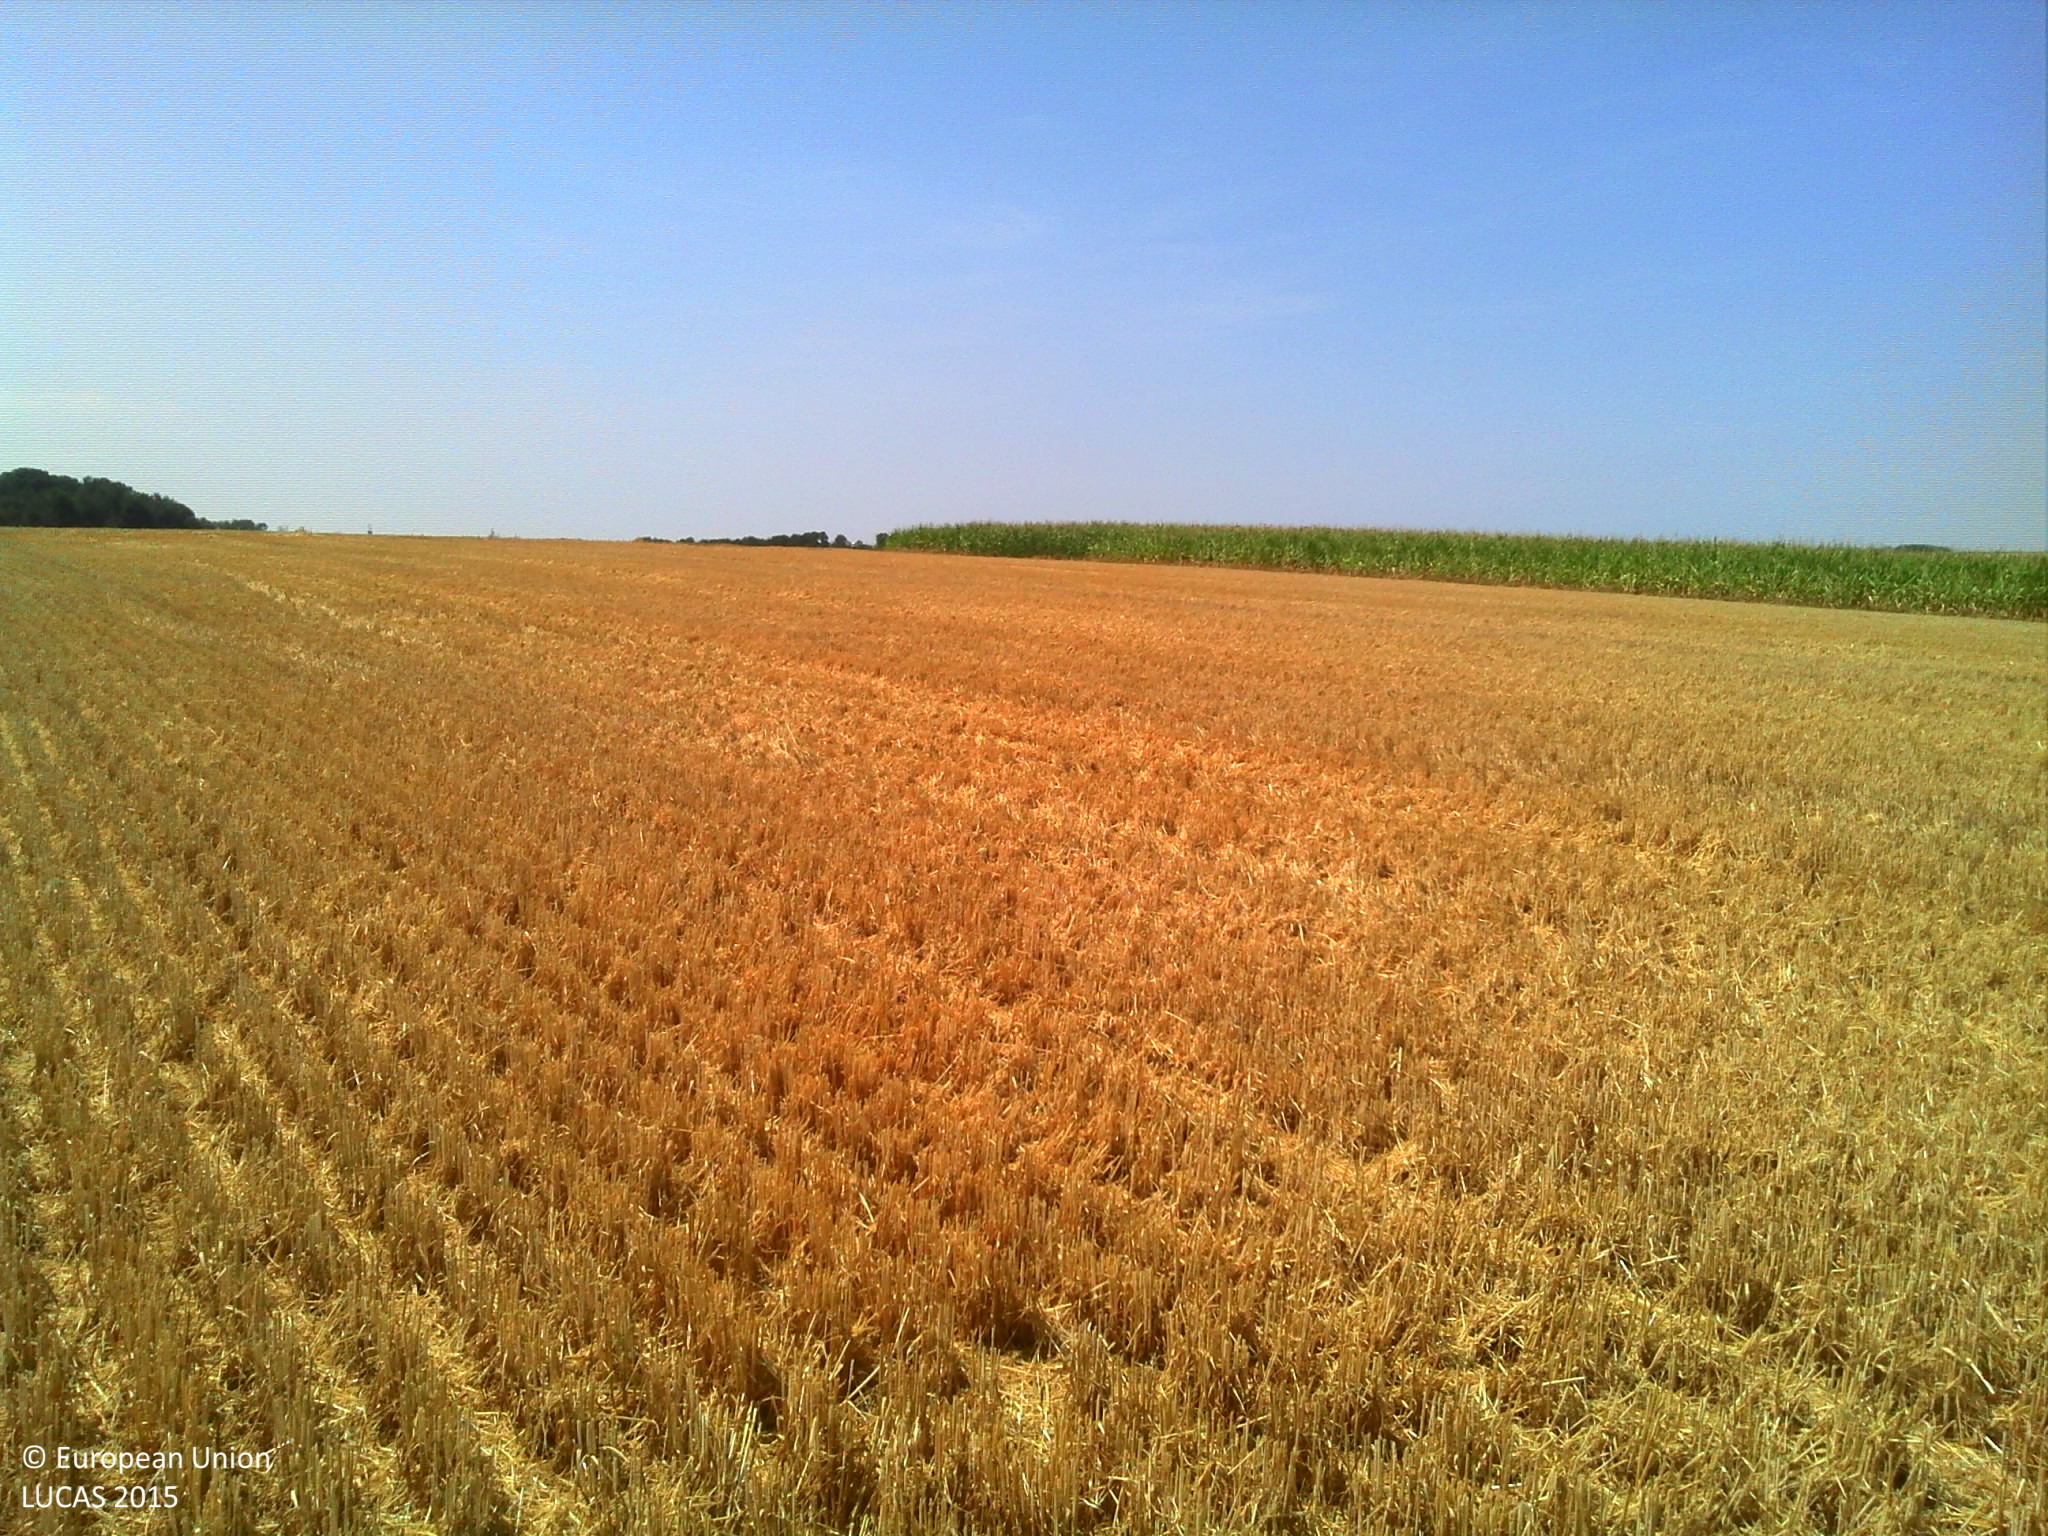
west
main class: Cropland
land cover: Barley
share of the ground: > 75 %
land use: Agriculture (excluding fallow land and kitchen gardens)
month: August
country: FR
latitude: 48.8339
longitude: 3.3309
